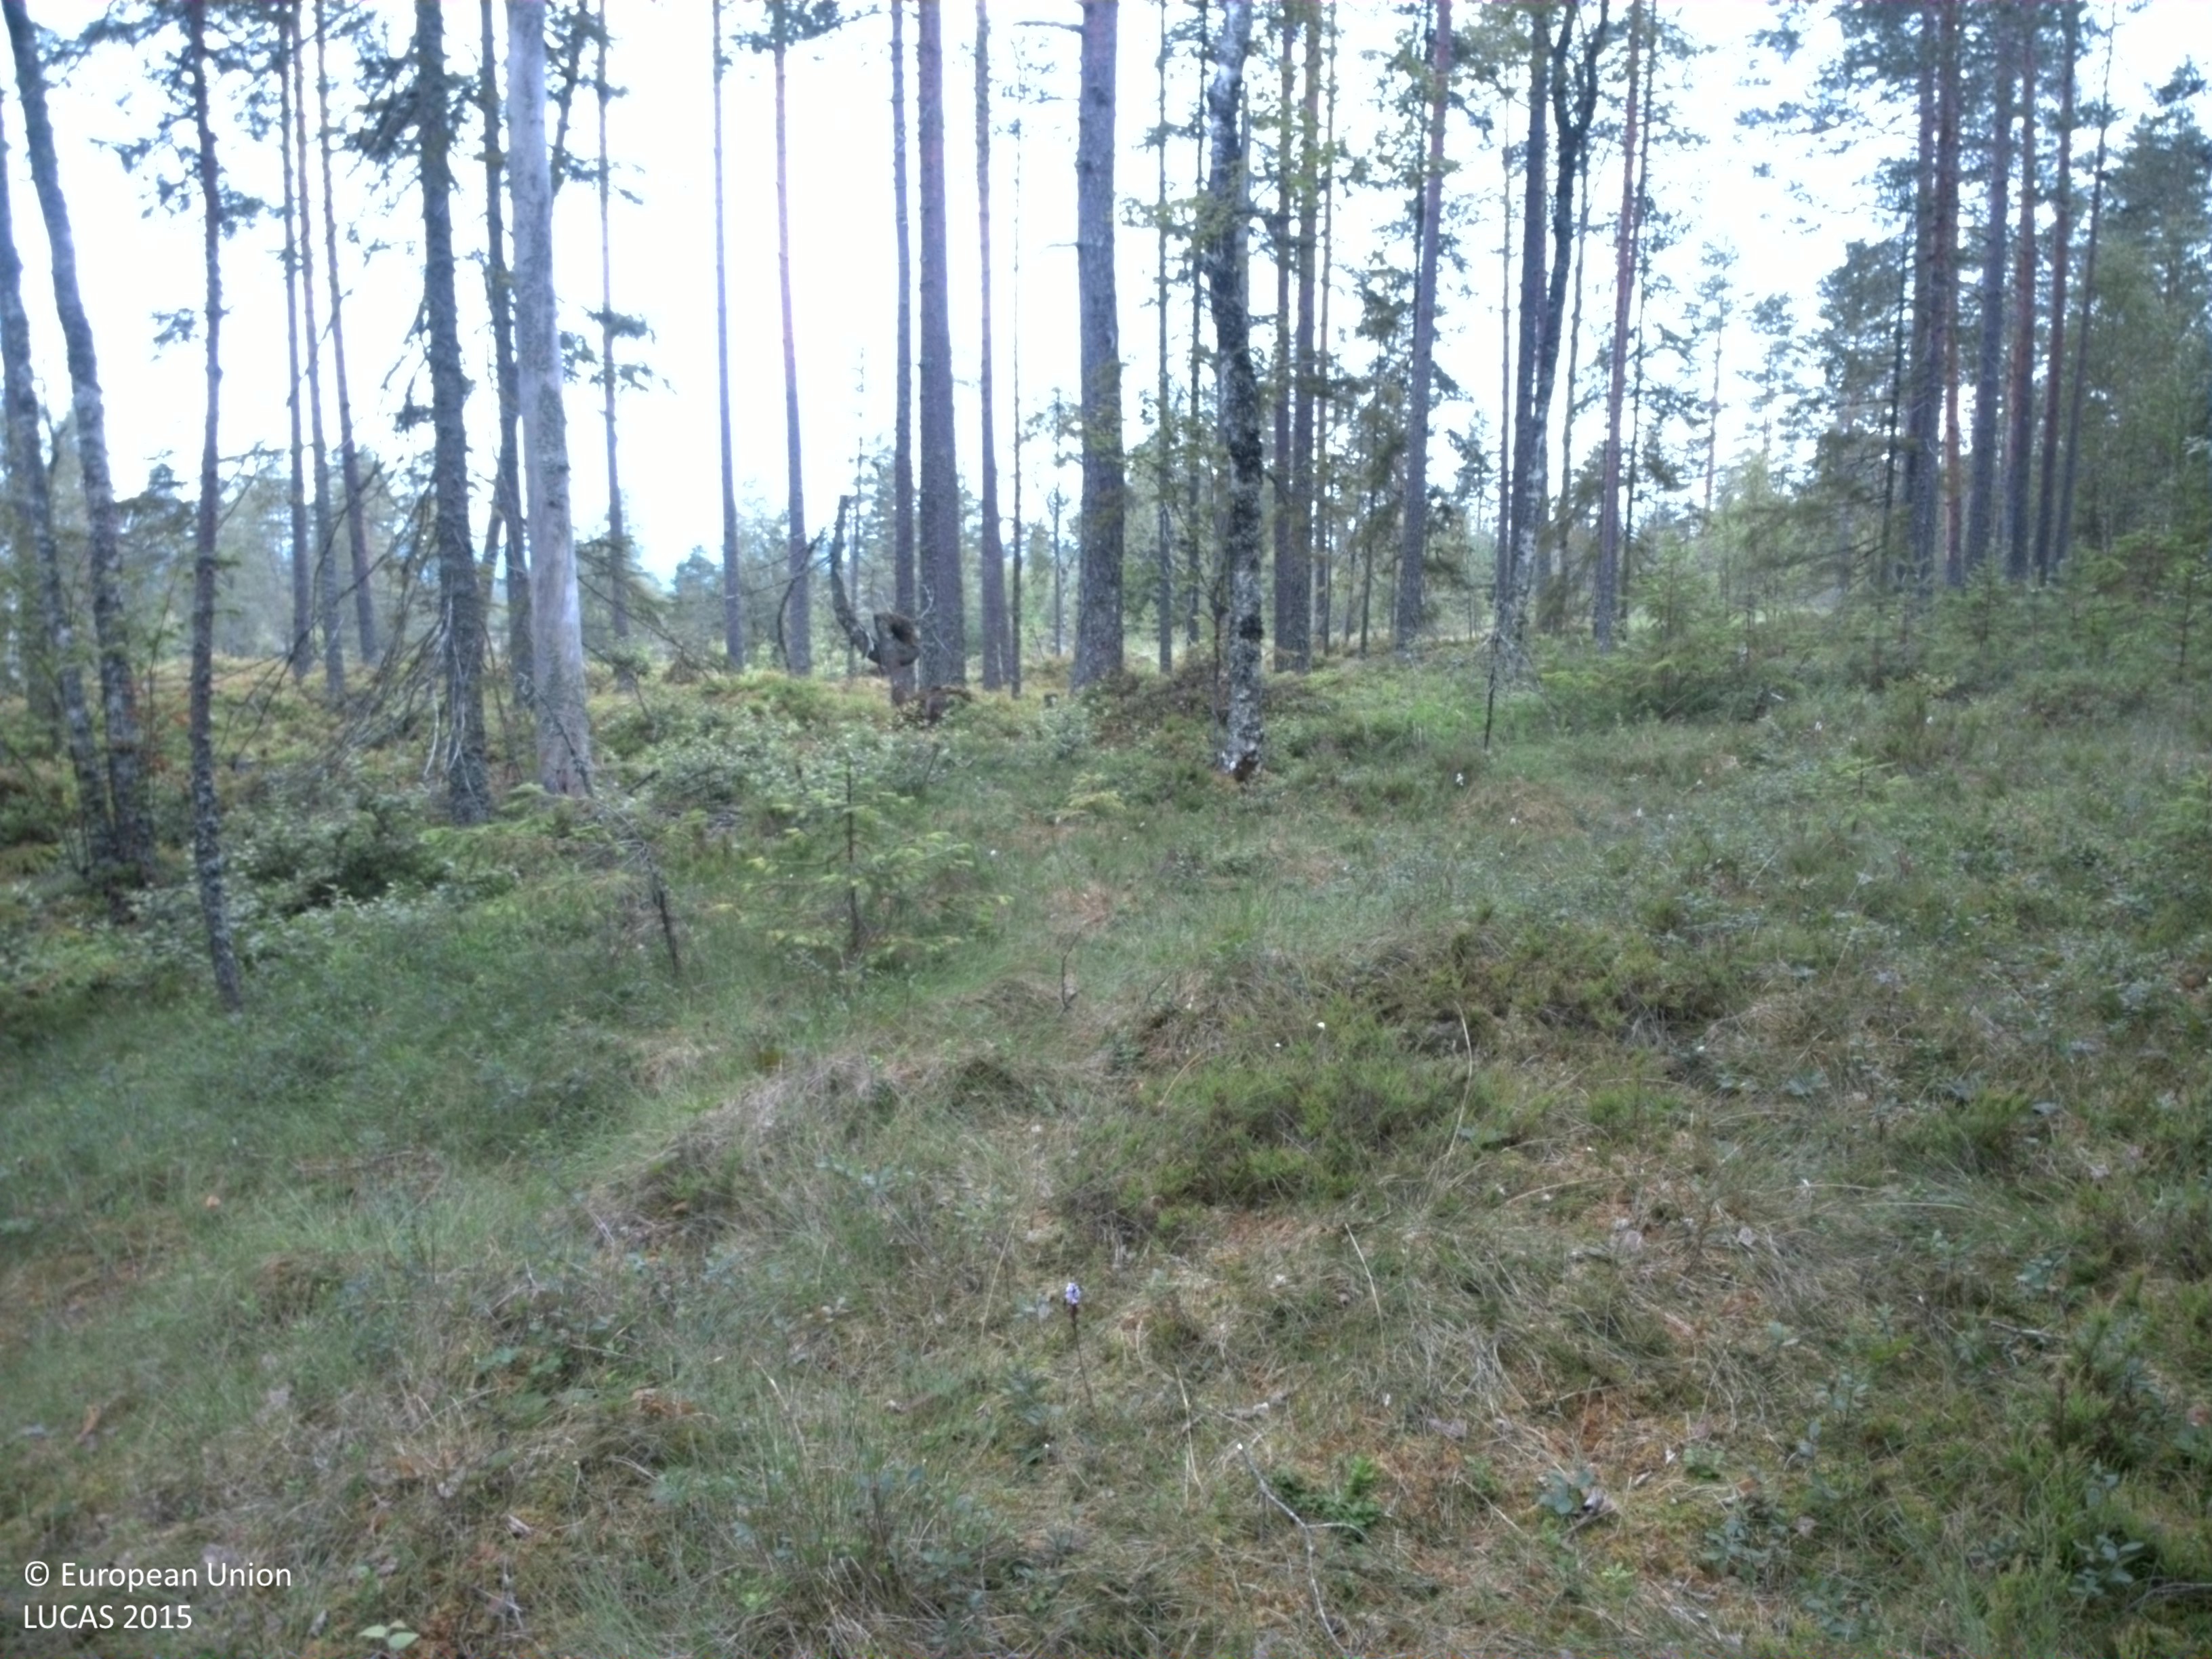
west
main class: Woodland
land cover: Pine dominated coniferous woodland
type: boreal forest
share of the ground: 25 - 50 %
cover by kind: coniferous forest trees 45 %, lichens and mosses 25 %, herbaceous plants 15 %, shrubs 10 %, broadleaved forest trees 5 %
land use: Forestry
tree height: > 5 m
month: August
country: SE
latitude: 60.3520
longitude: 13.5602
